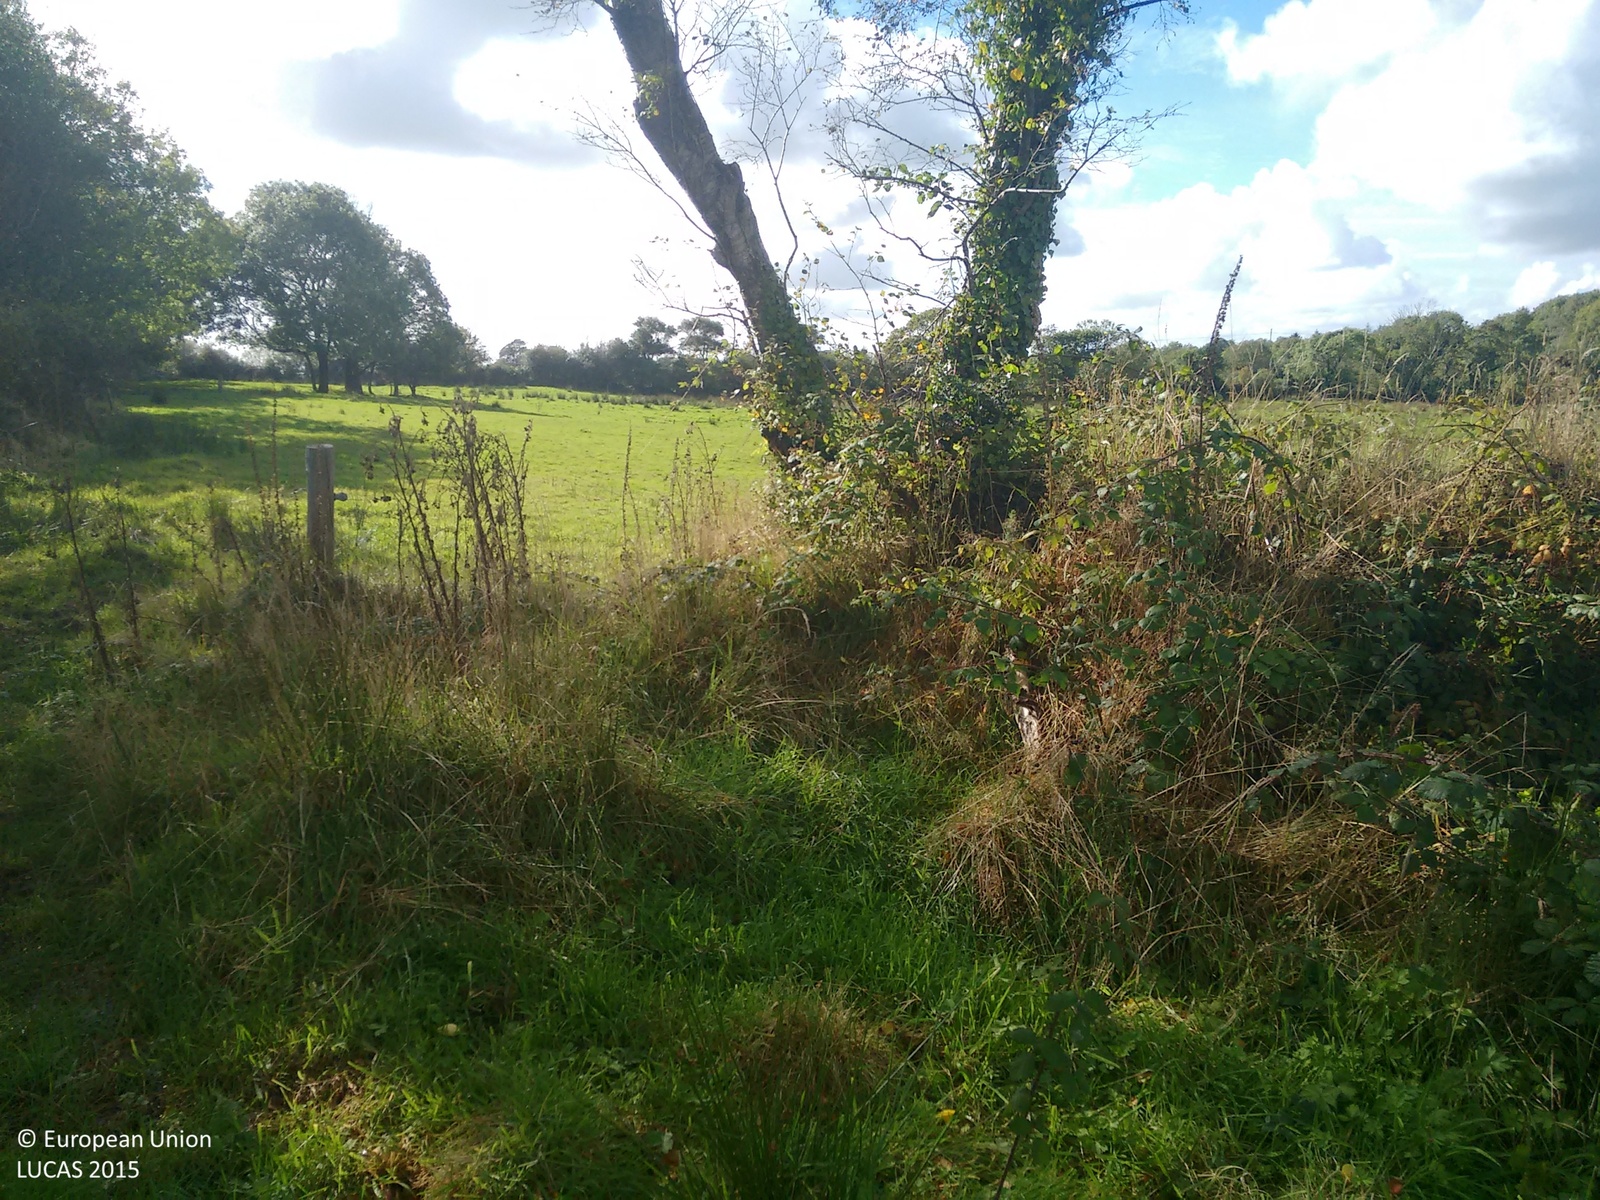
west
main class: Grassland
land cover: Grassland without tree/shrub cover
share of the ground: > 75 %
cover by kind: herbaceous plants 95 %, shrubs 5 %
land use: Agriculture (excluding fallow land and kitchen gardens)
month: September
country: IE
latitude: 52.4823
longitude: -9.4776
